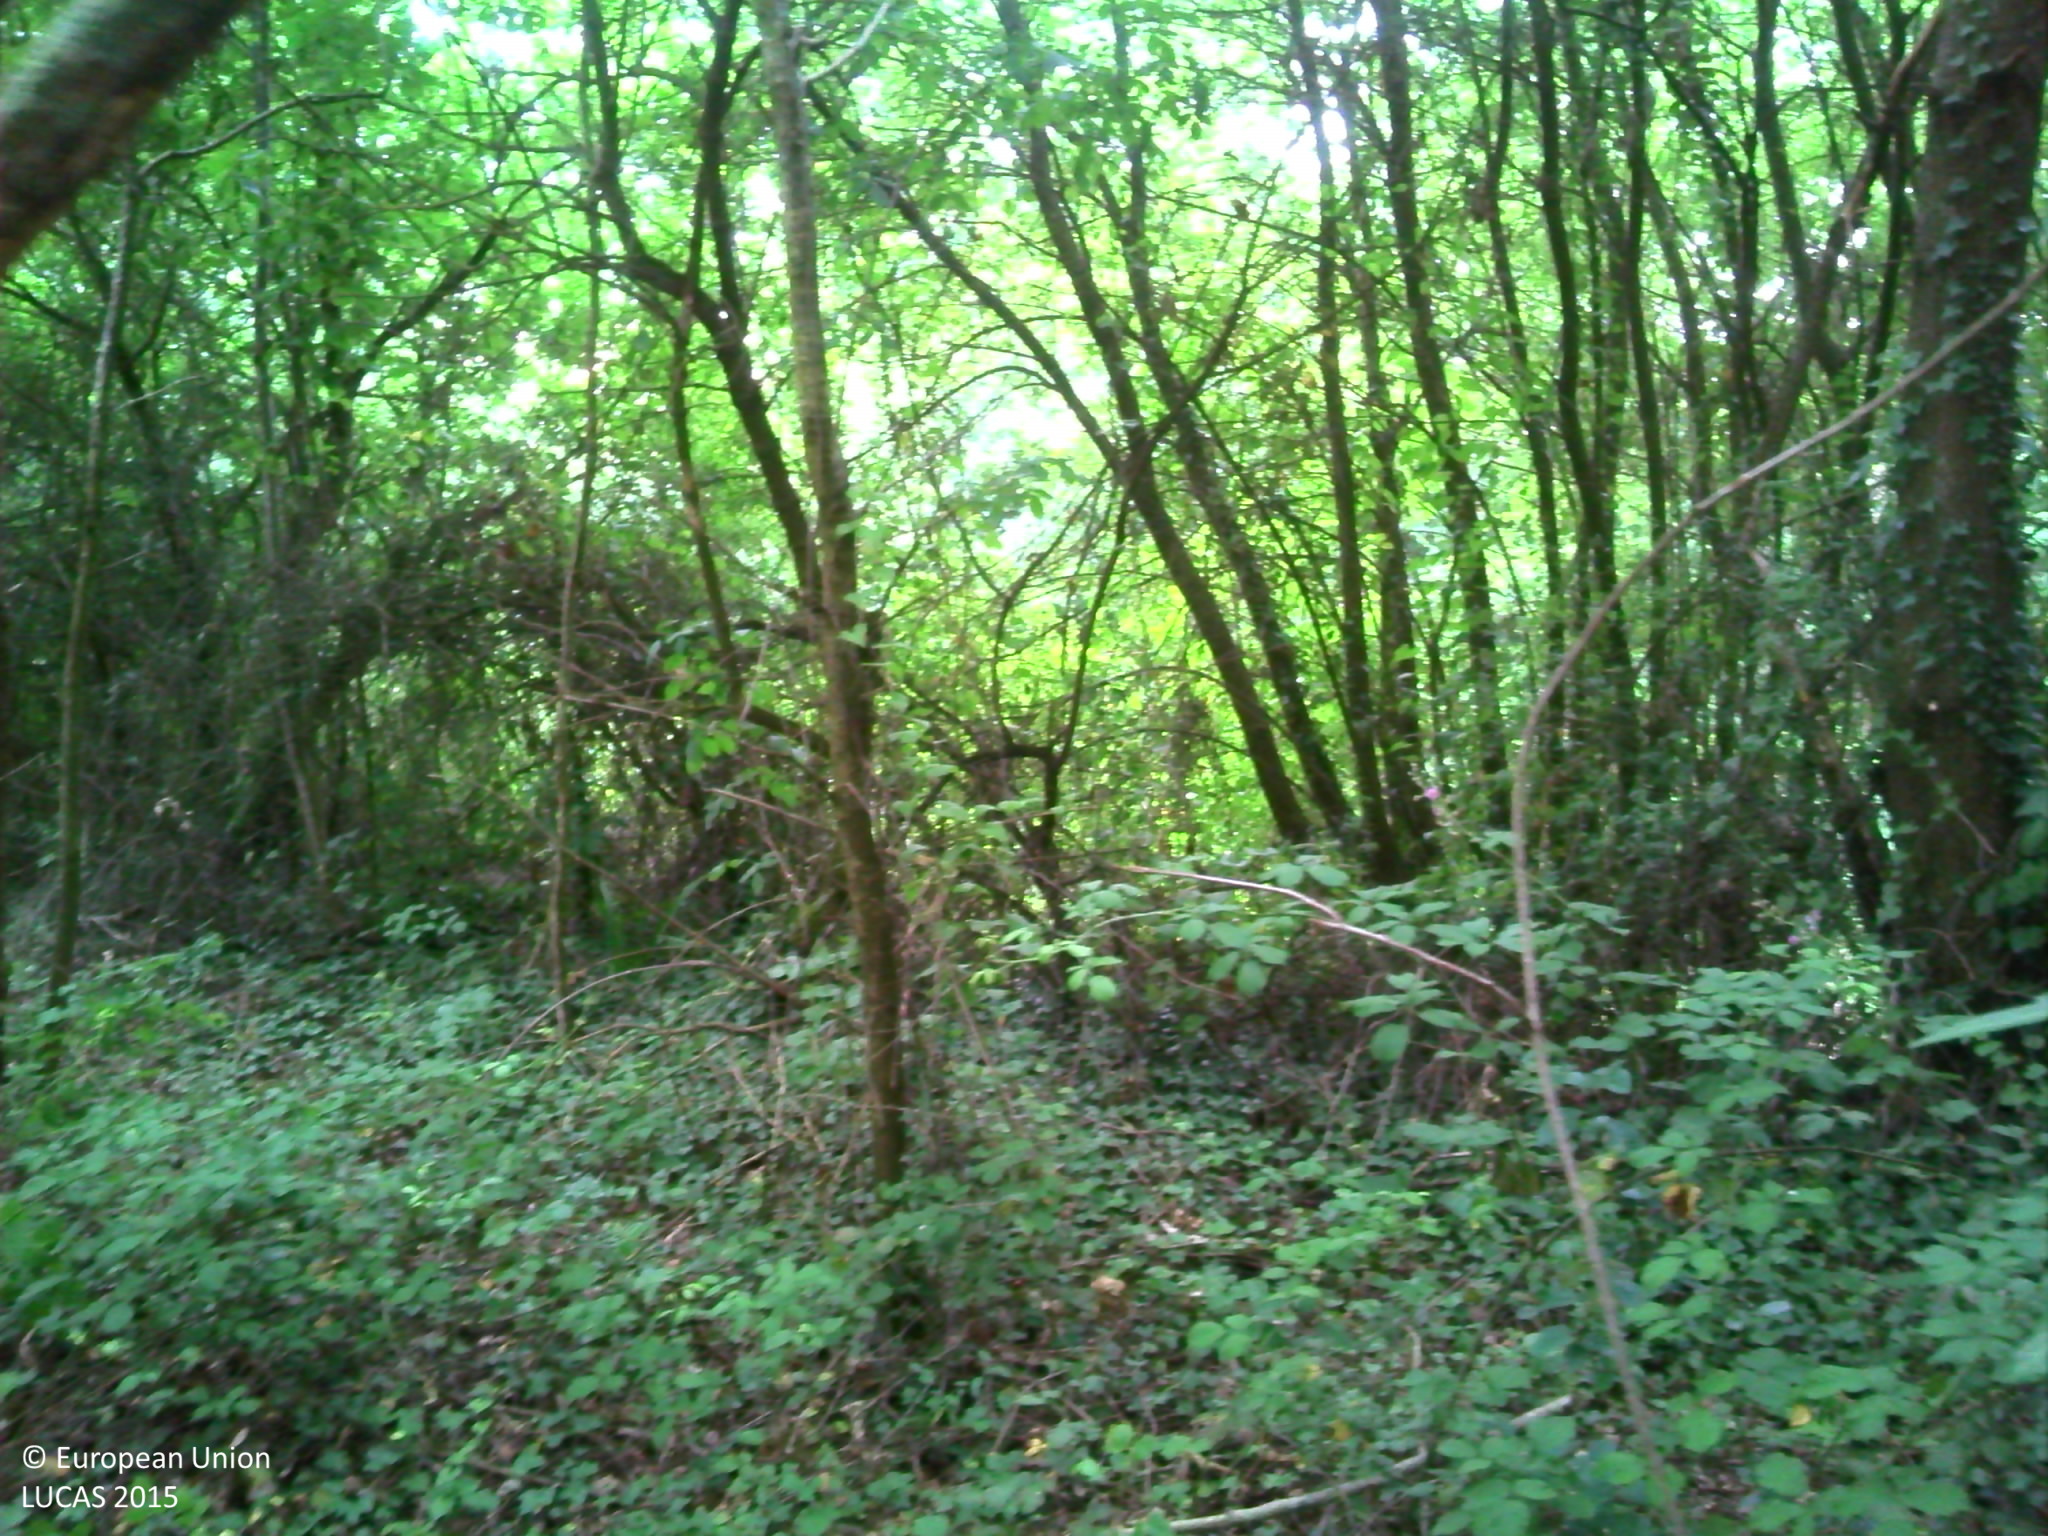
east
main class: Woodland
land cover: Broadleaved woodland
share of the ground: > 75 %
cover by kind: broadleaved forest trees 95 %, herbaceous plants 5 %
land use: Semi-natural and natural areas not in use
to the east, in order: Broadleaved woodland; Electric lines; Railways; Shrubland with sparse tree cover; Grassland with sparse tree/shrub cover; Shrubland with sparse tree cover; Grass margins; Tracks; Grass margins; Broadleaved woodland; Fences; Grassland without tree/shrub cover
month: July
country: FR
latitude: 47.1215
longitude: -1.7356
